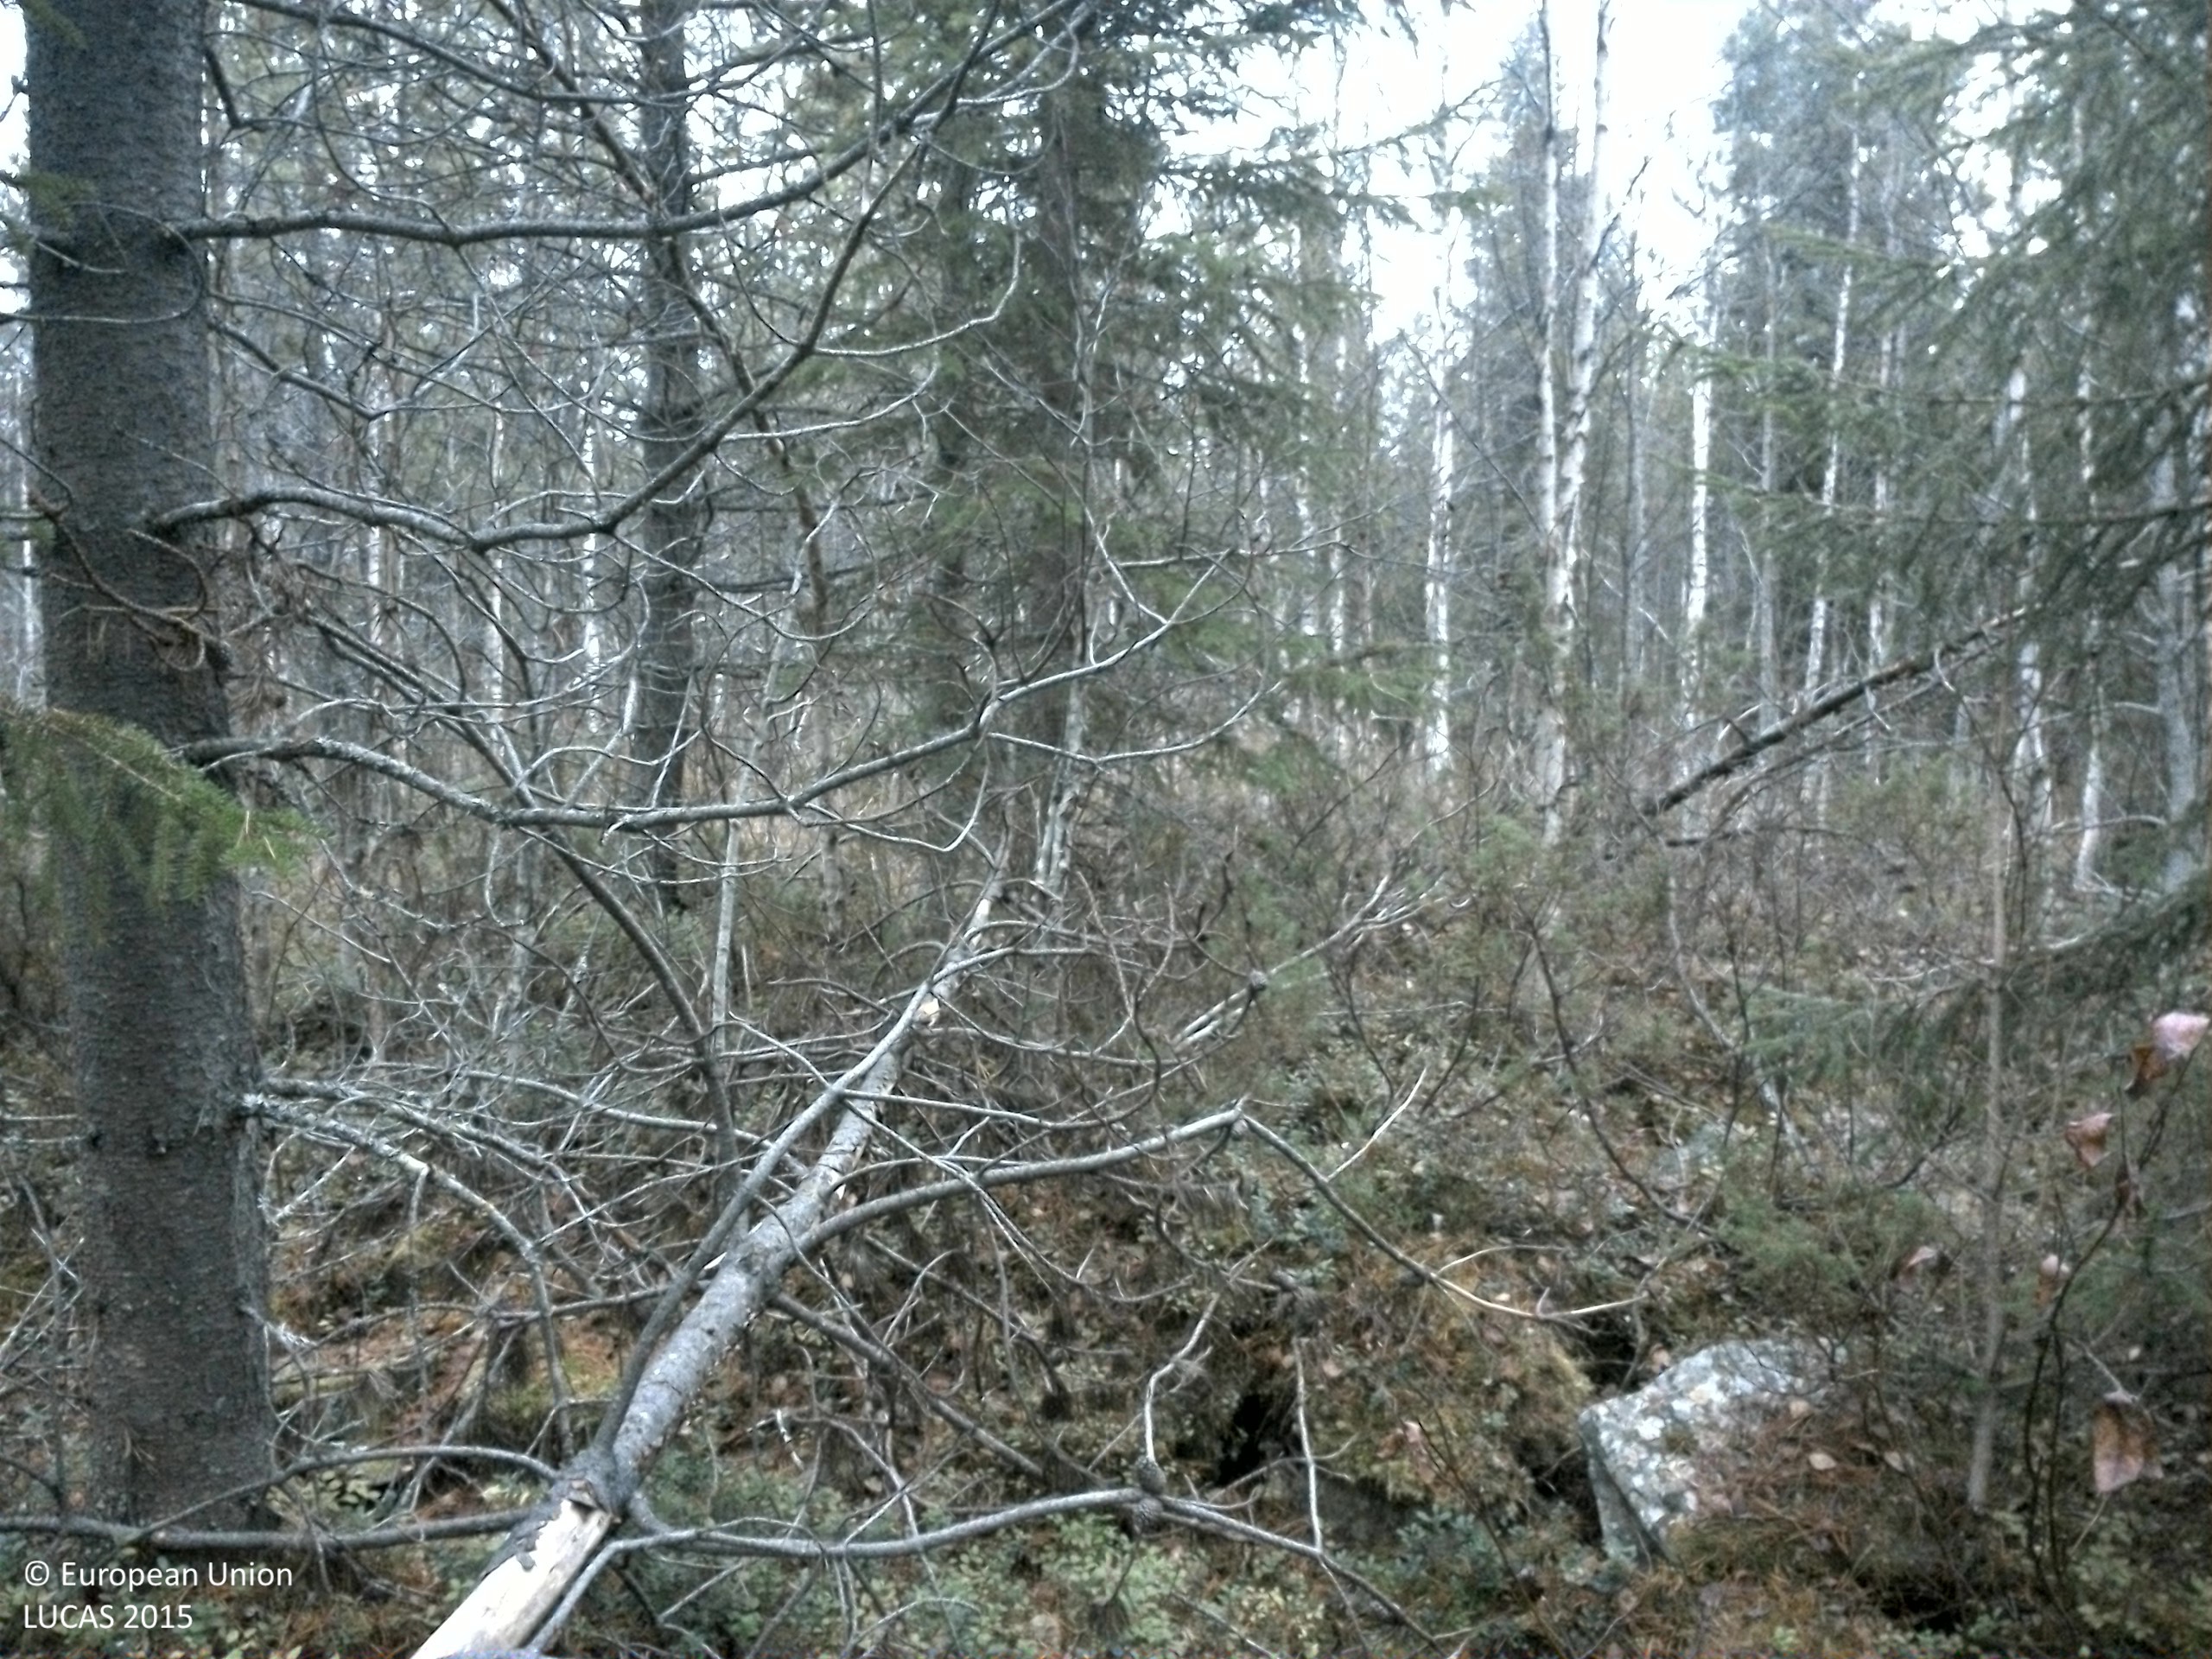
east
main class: Woodland
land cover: Pine dominated mixed woodland
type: exotic forest
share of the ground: 50 - 75 %
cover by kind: coniferous forest trees 40 %, shrubs 25 %, broadleaved forest trees 15 %, lichens and mosses 15 %, herbaceous plants 5 %
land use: Forestry
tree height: > 5 m
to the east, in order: Pine dominated mixed woodland; Ditches and canals; Pine dominated mixed woodland; Ditches and canals; Spruce dominated mixed woodland; Pine dominated coniferous woodland; Tracks; Pine dominated coniferous woodland
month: October
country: SE
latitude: 64.2809
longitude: 15.6093
